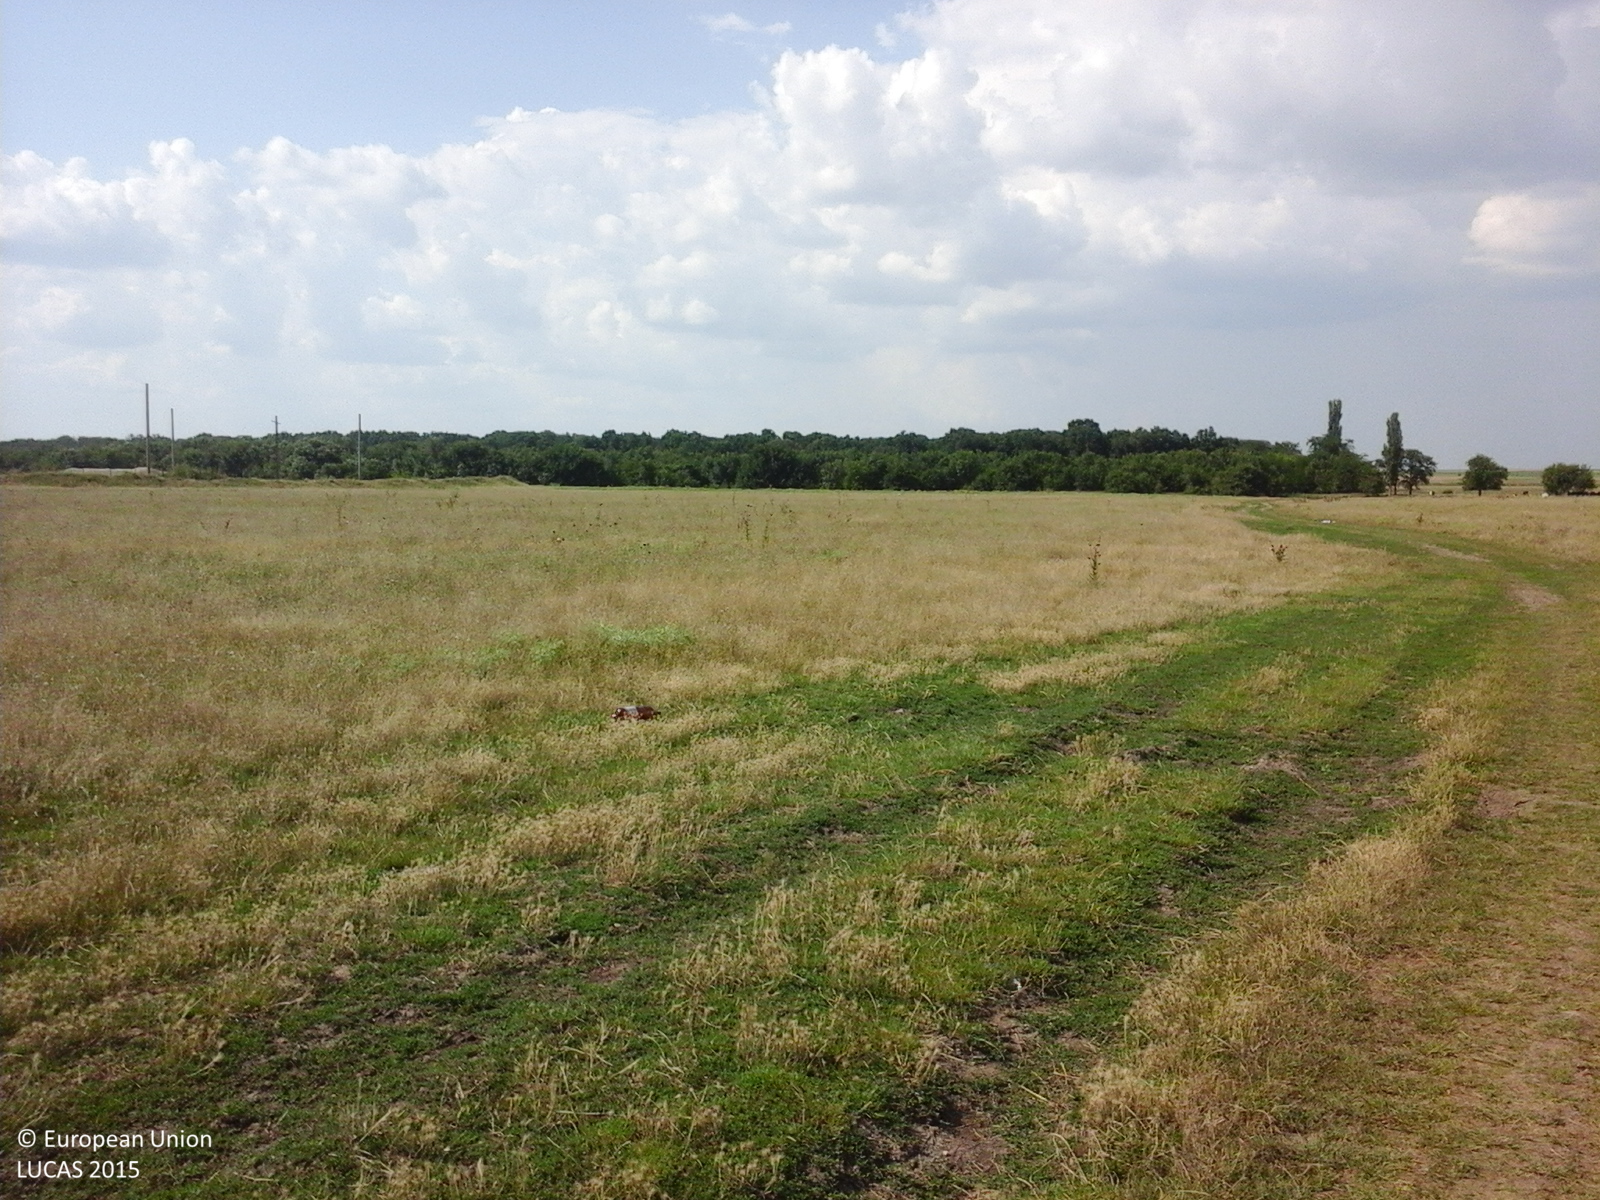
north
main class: Grassland
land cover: Grassland without tree/shrub cover
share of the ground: > 75 %
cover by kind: herbaceous plants 100 %
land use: Agriculture (excluding fallow land and kitchen gardens)
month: July
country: RO
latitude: 43.9986
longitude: 25.2838
